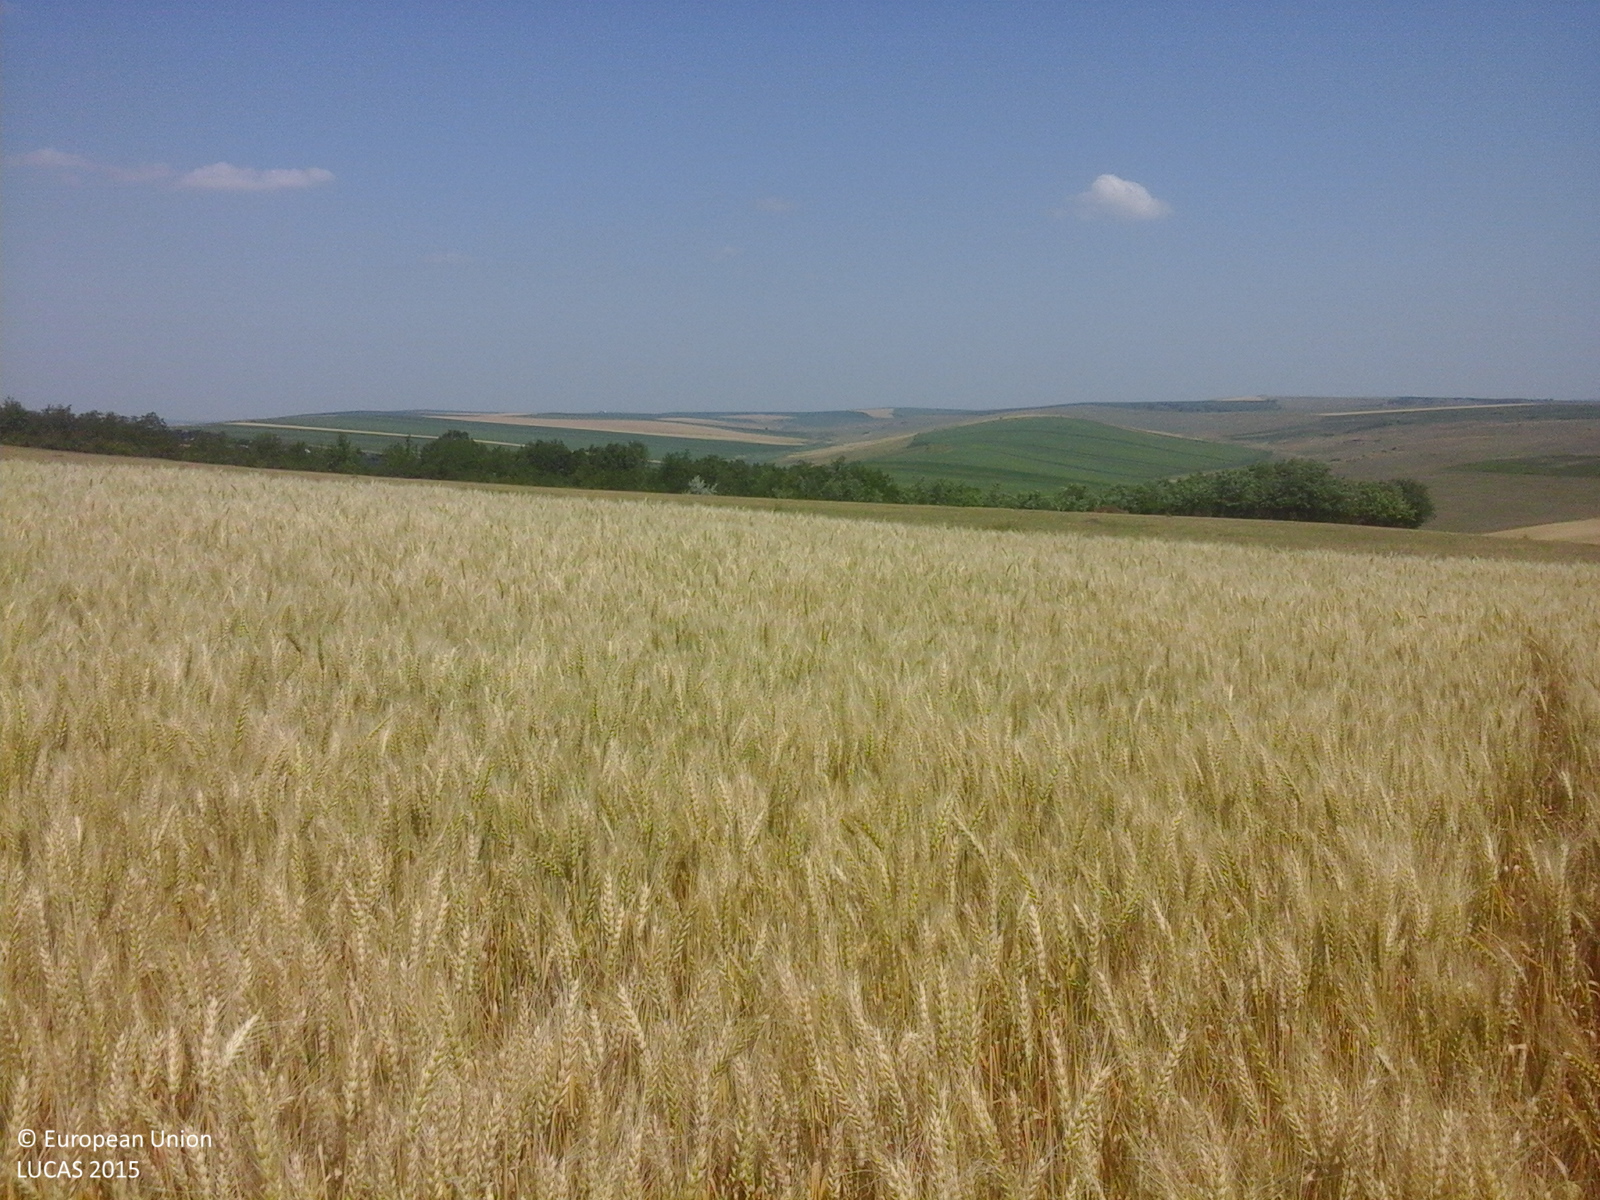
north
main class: Cropland
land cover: Common wheat
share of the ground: > 75 %
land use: Agriculture (excluding fallow land and kitchen gardens)
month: June
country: RO
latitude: 47.2467
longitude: 27.2990
